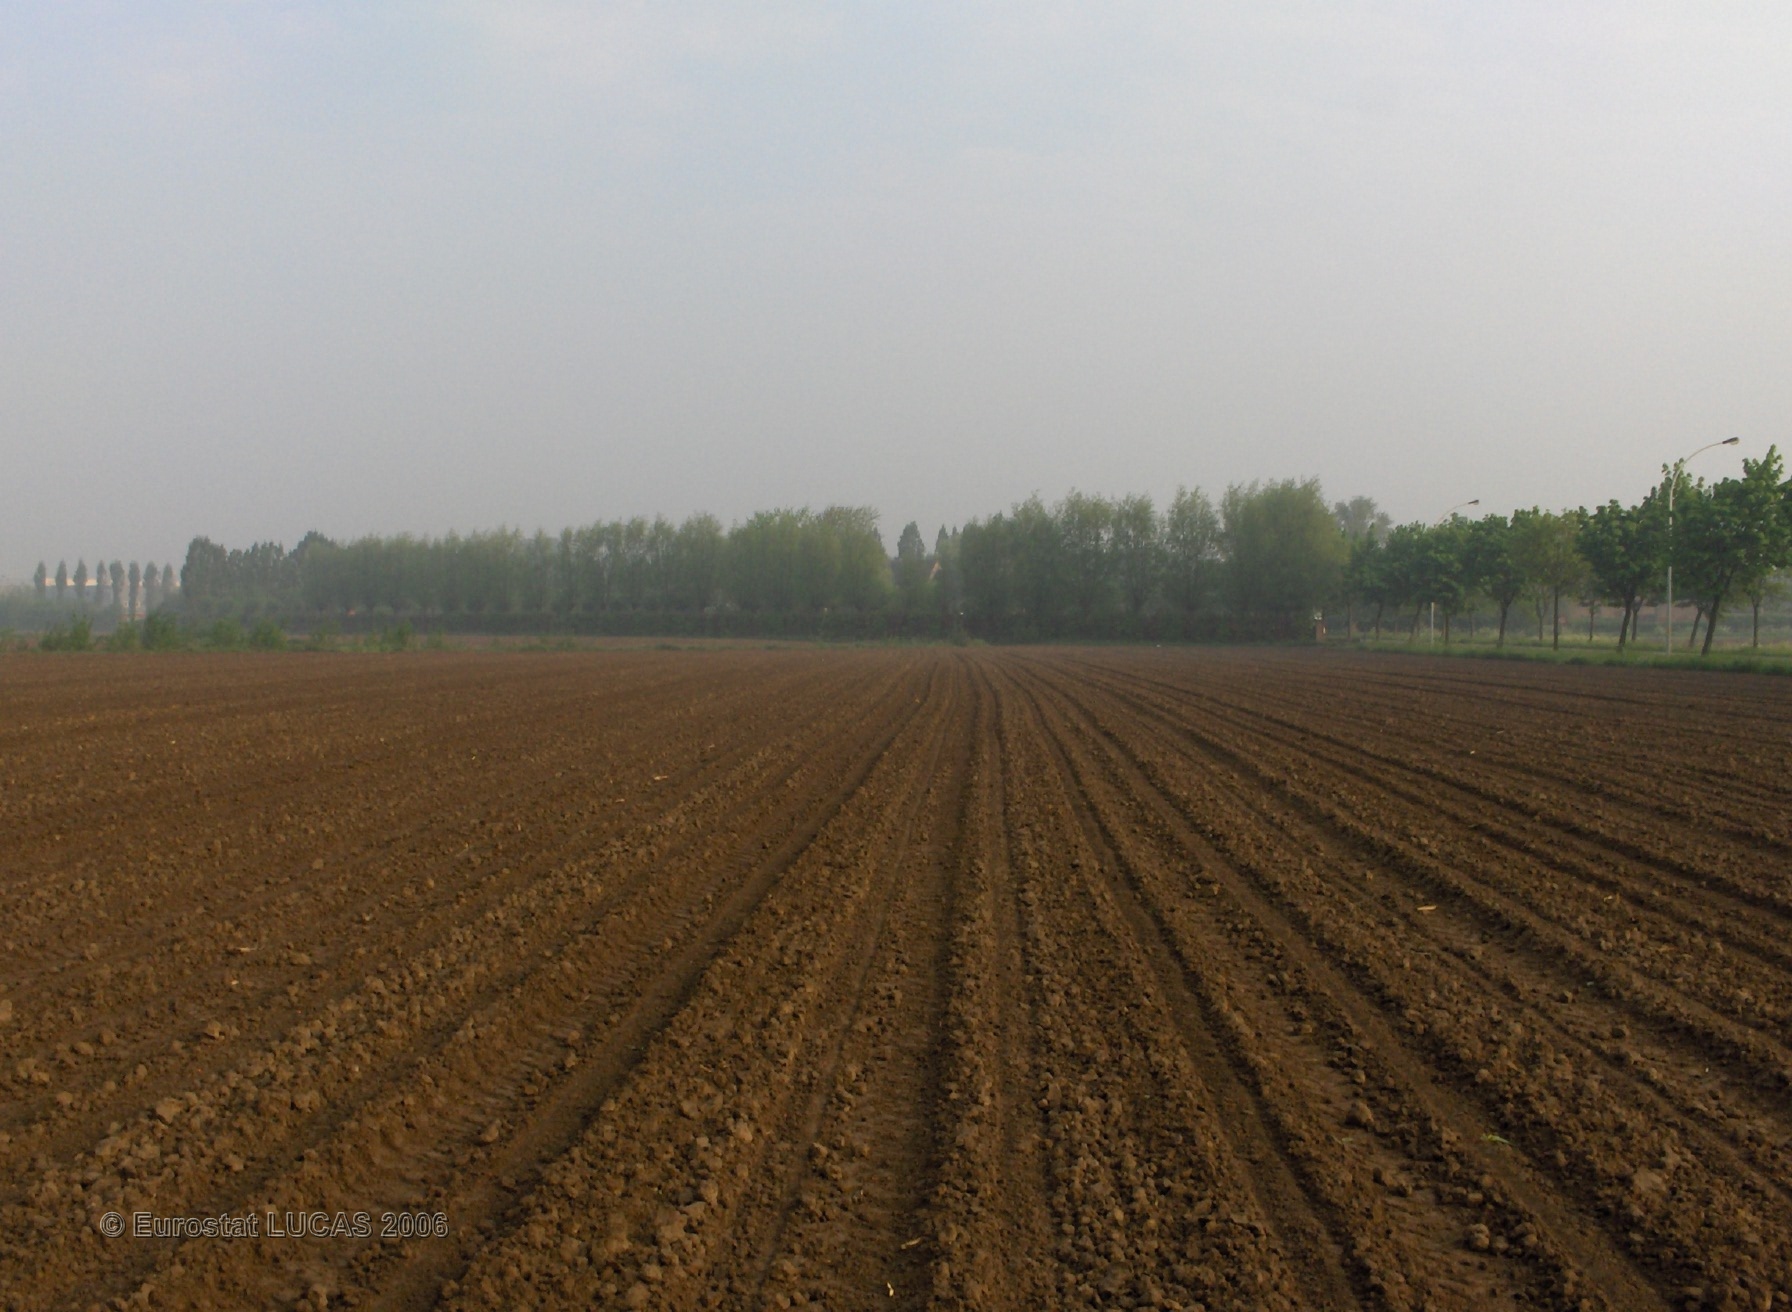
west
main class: Cropland
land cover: Maize
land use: Agriculture (excluding fallow land and kitchen gardens)
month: May
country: BE
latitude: 51.1464
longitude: 4.4062
